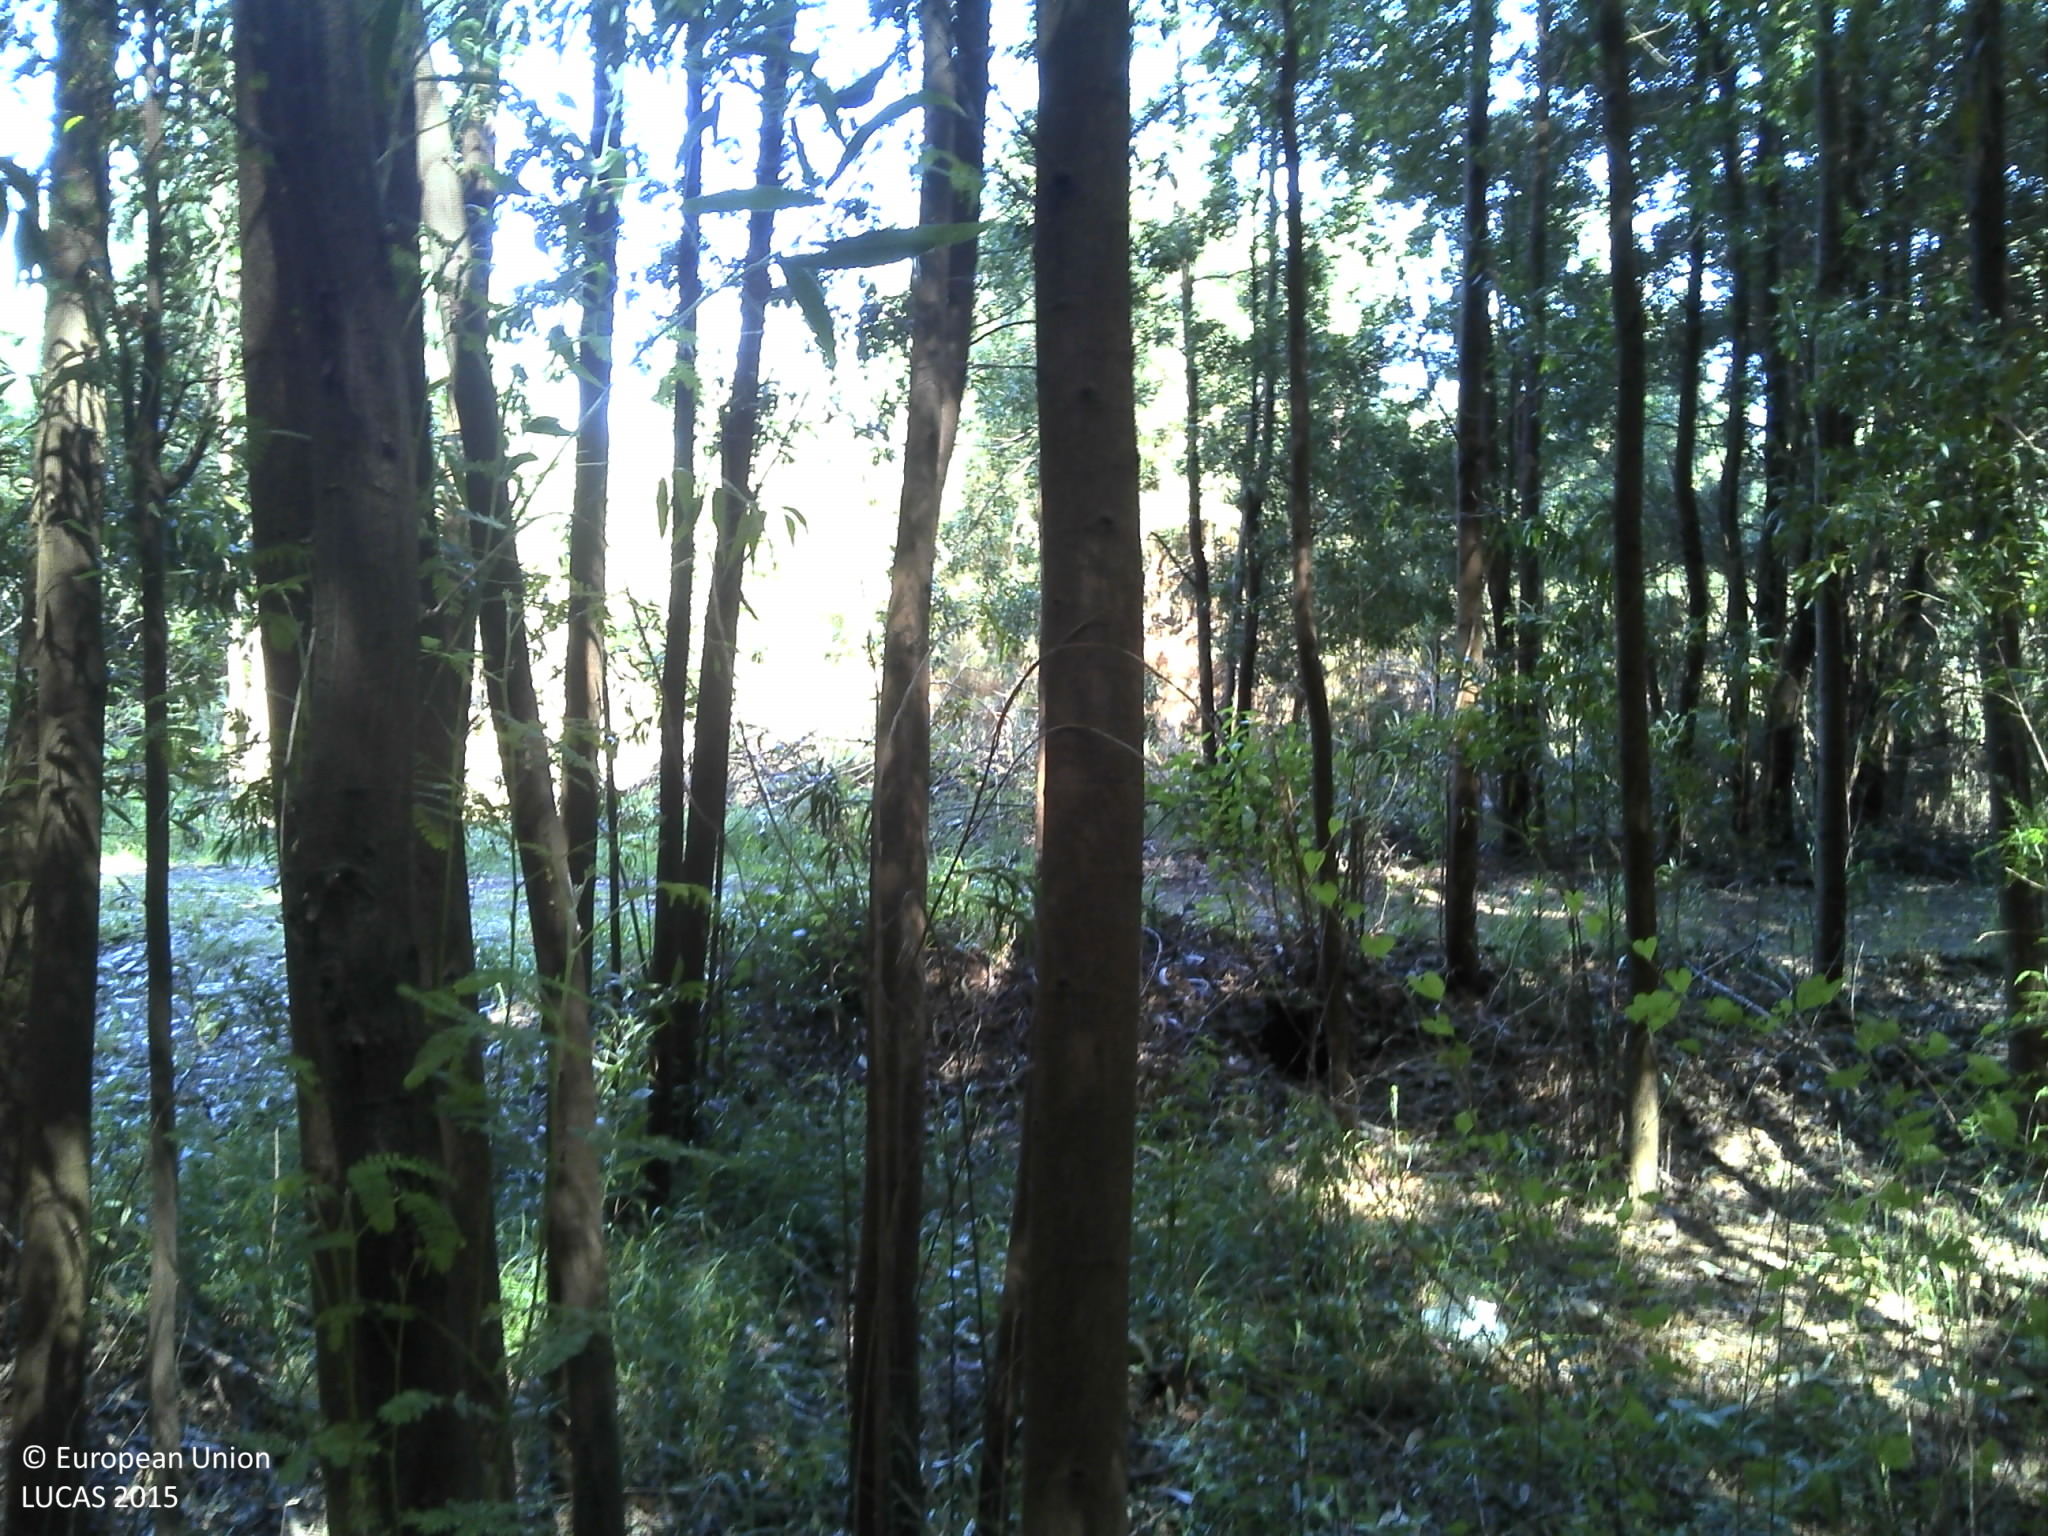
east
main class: Woodland
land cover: Broadleaved woodland
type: exotic forest
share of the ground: 50 - 75 %
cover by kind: broadleaved forest trees 75 %, shrubs 10 %, unconsolidated bare surface 10 %, herbaceous plants 5 %
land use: Forestry
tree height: > 5 m
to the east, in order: Broadleaved woodland; Tracks; Broadleaved woodland; Pine dominated coniferous woodland; Tracks; Pine dominated coniferous woodland
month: May
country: PT
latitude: 40.4604
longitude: -8.7415
